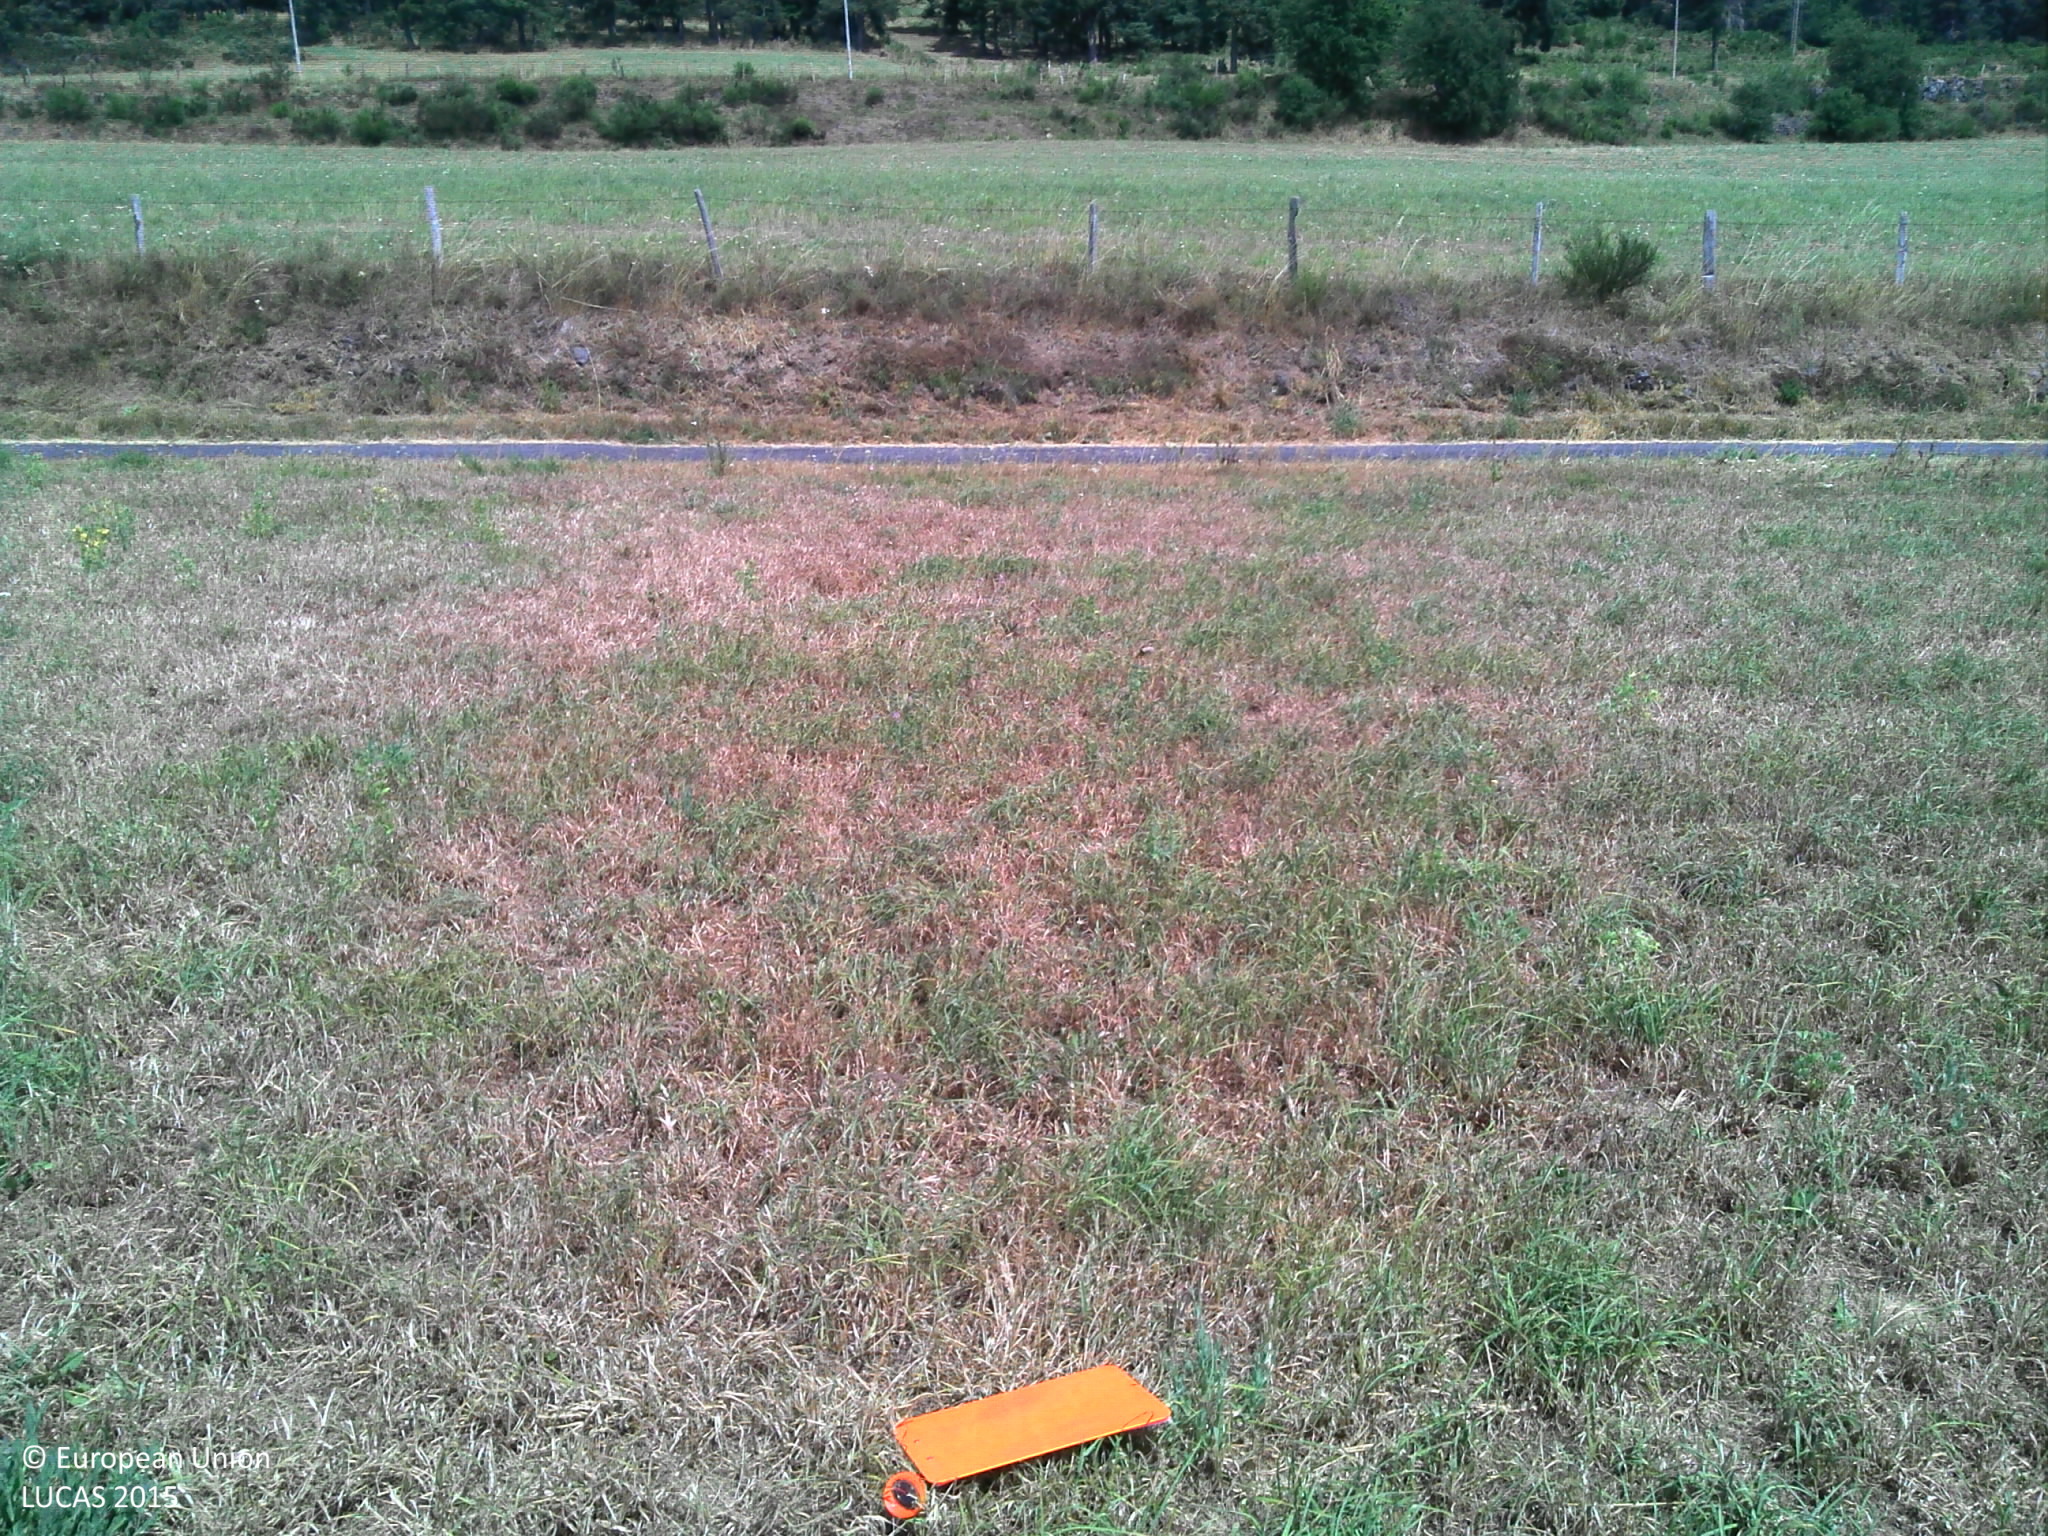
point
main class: Grassland
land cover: Grassland without tree/shrub cover
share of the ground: > 75 %
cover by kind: herbaceous plants 100 %
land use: Agriculture (excluding fallow land and kitchen gardens)
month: July
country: FR
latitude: 44.6780
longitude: 3.9121
